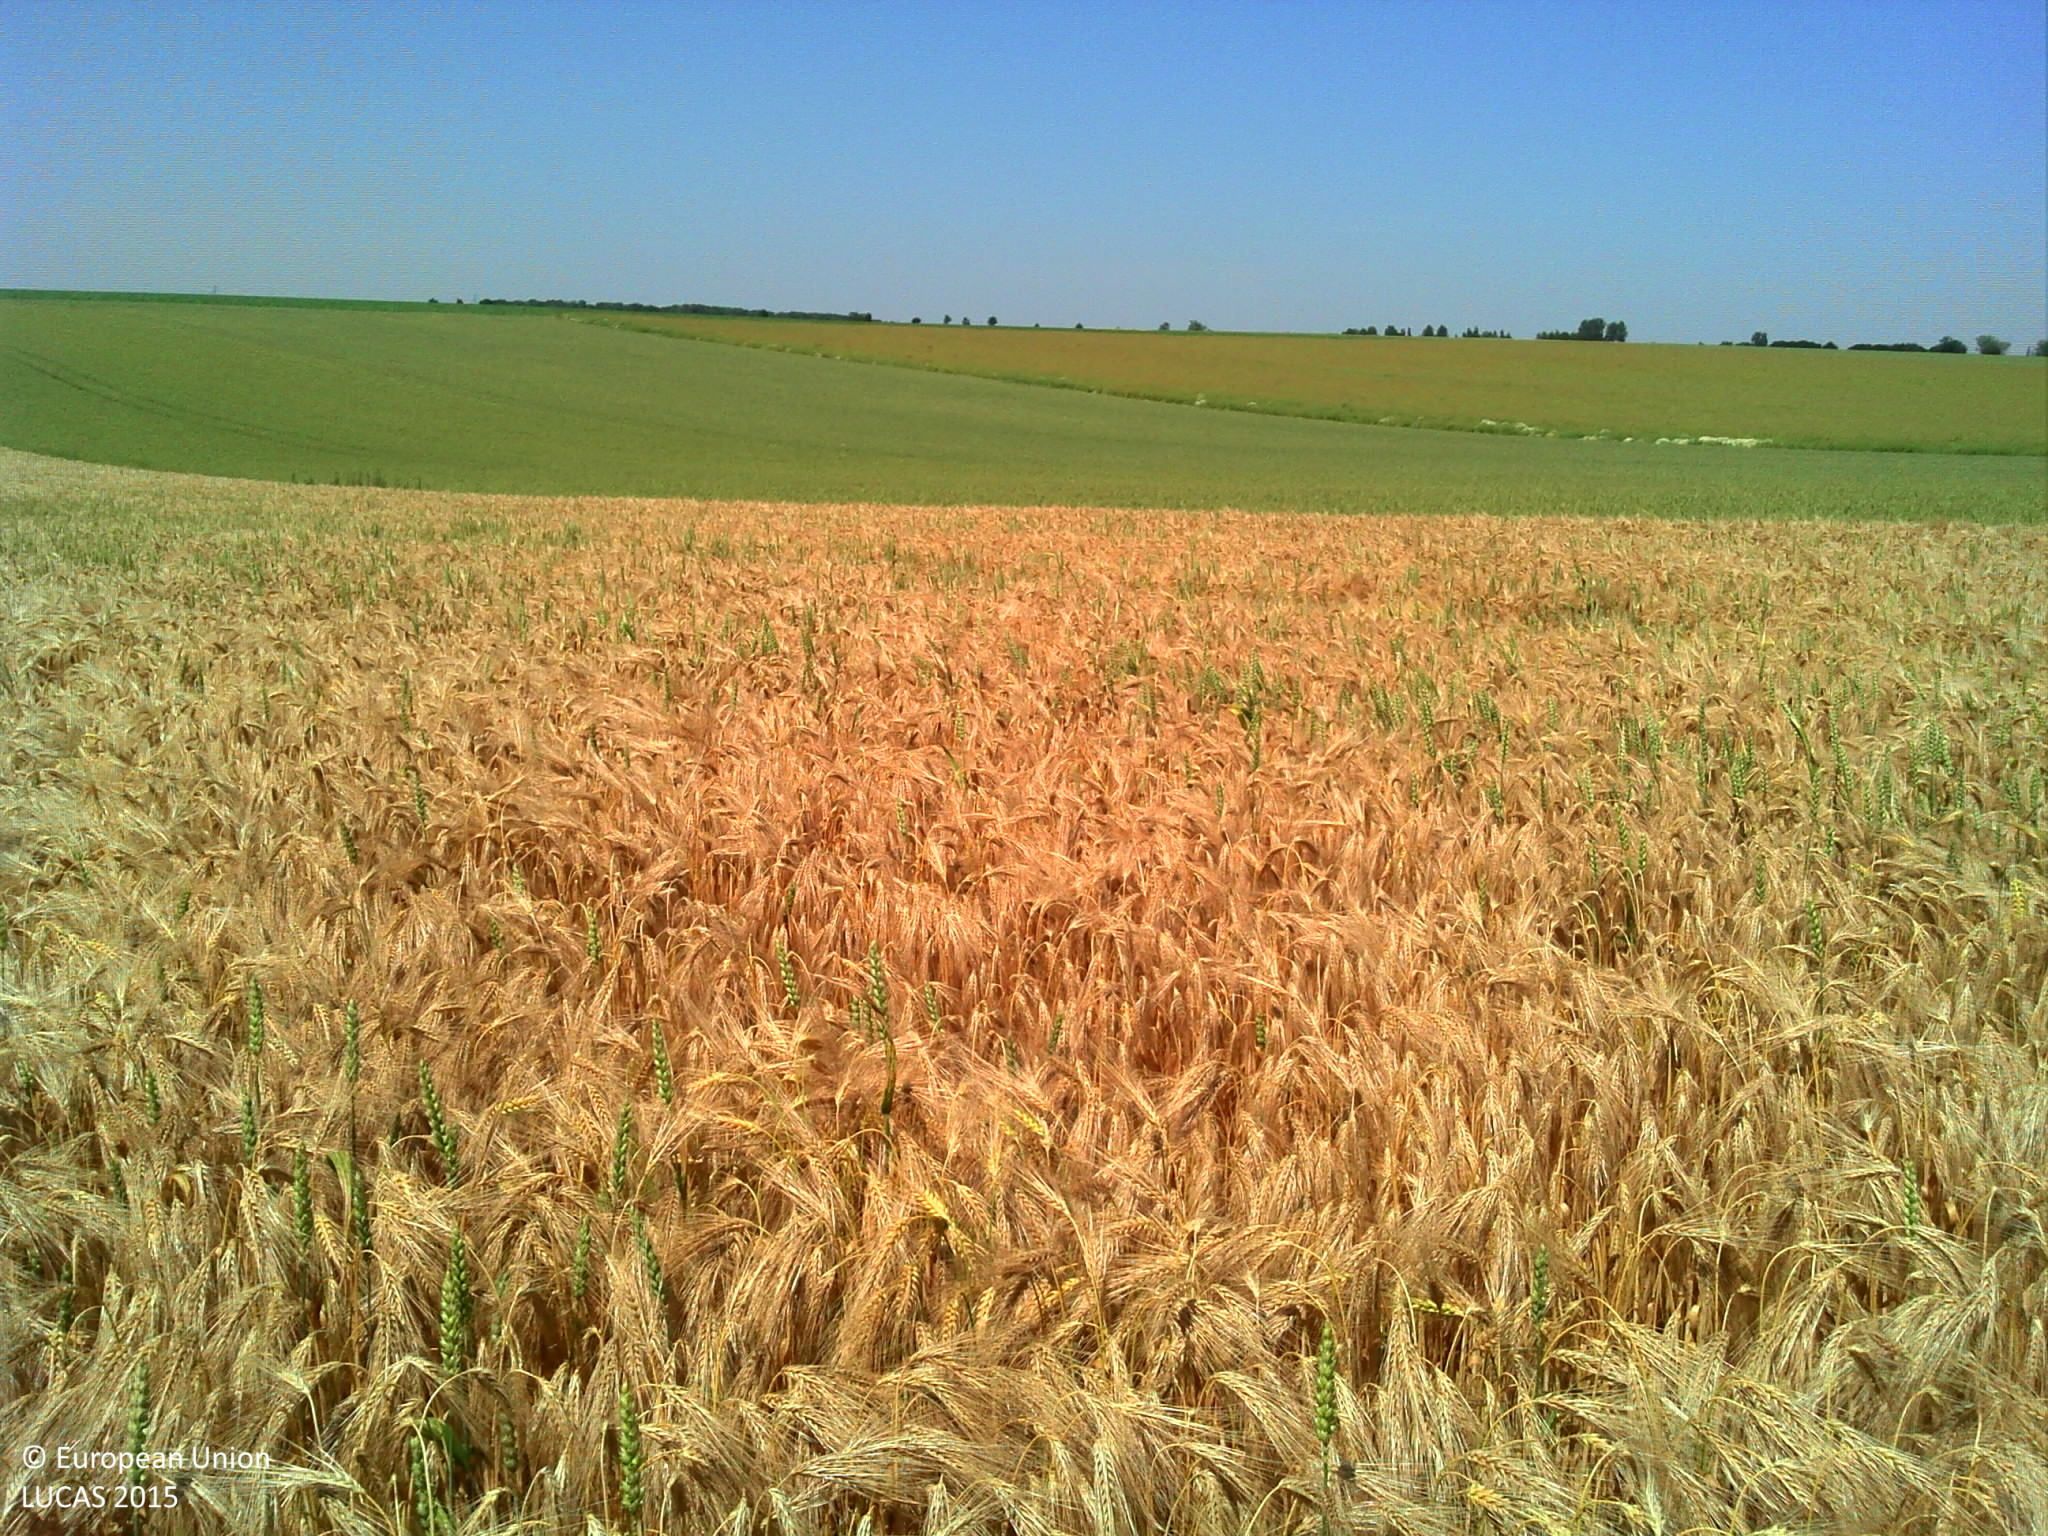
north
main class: Cropland
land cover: Barley
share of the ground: > 75 %
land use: Agriculture (excluding fallow land and kitchen gardens)
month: July
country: FR
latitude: 50.2253
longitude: 2.4883
